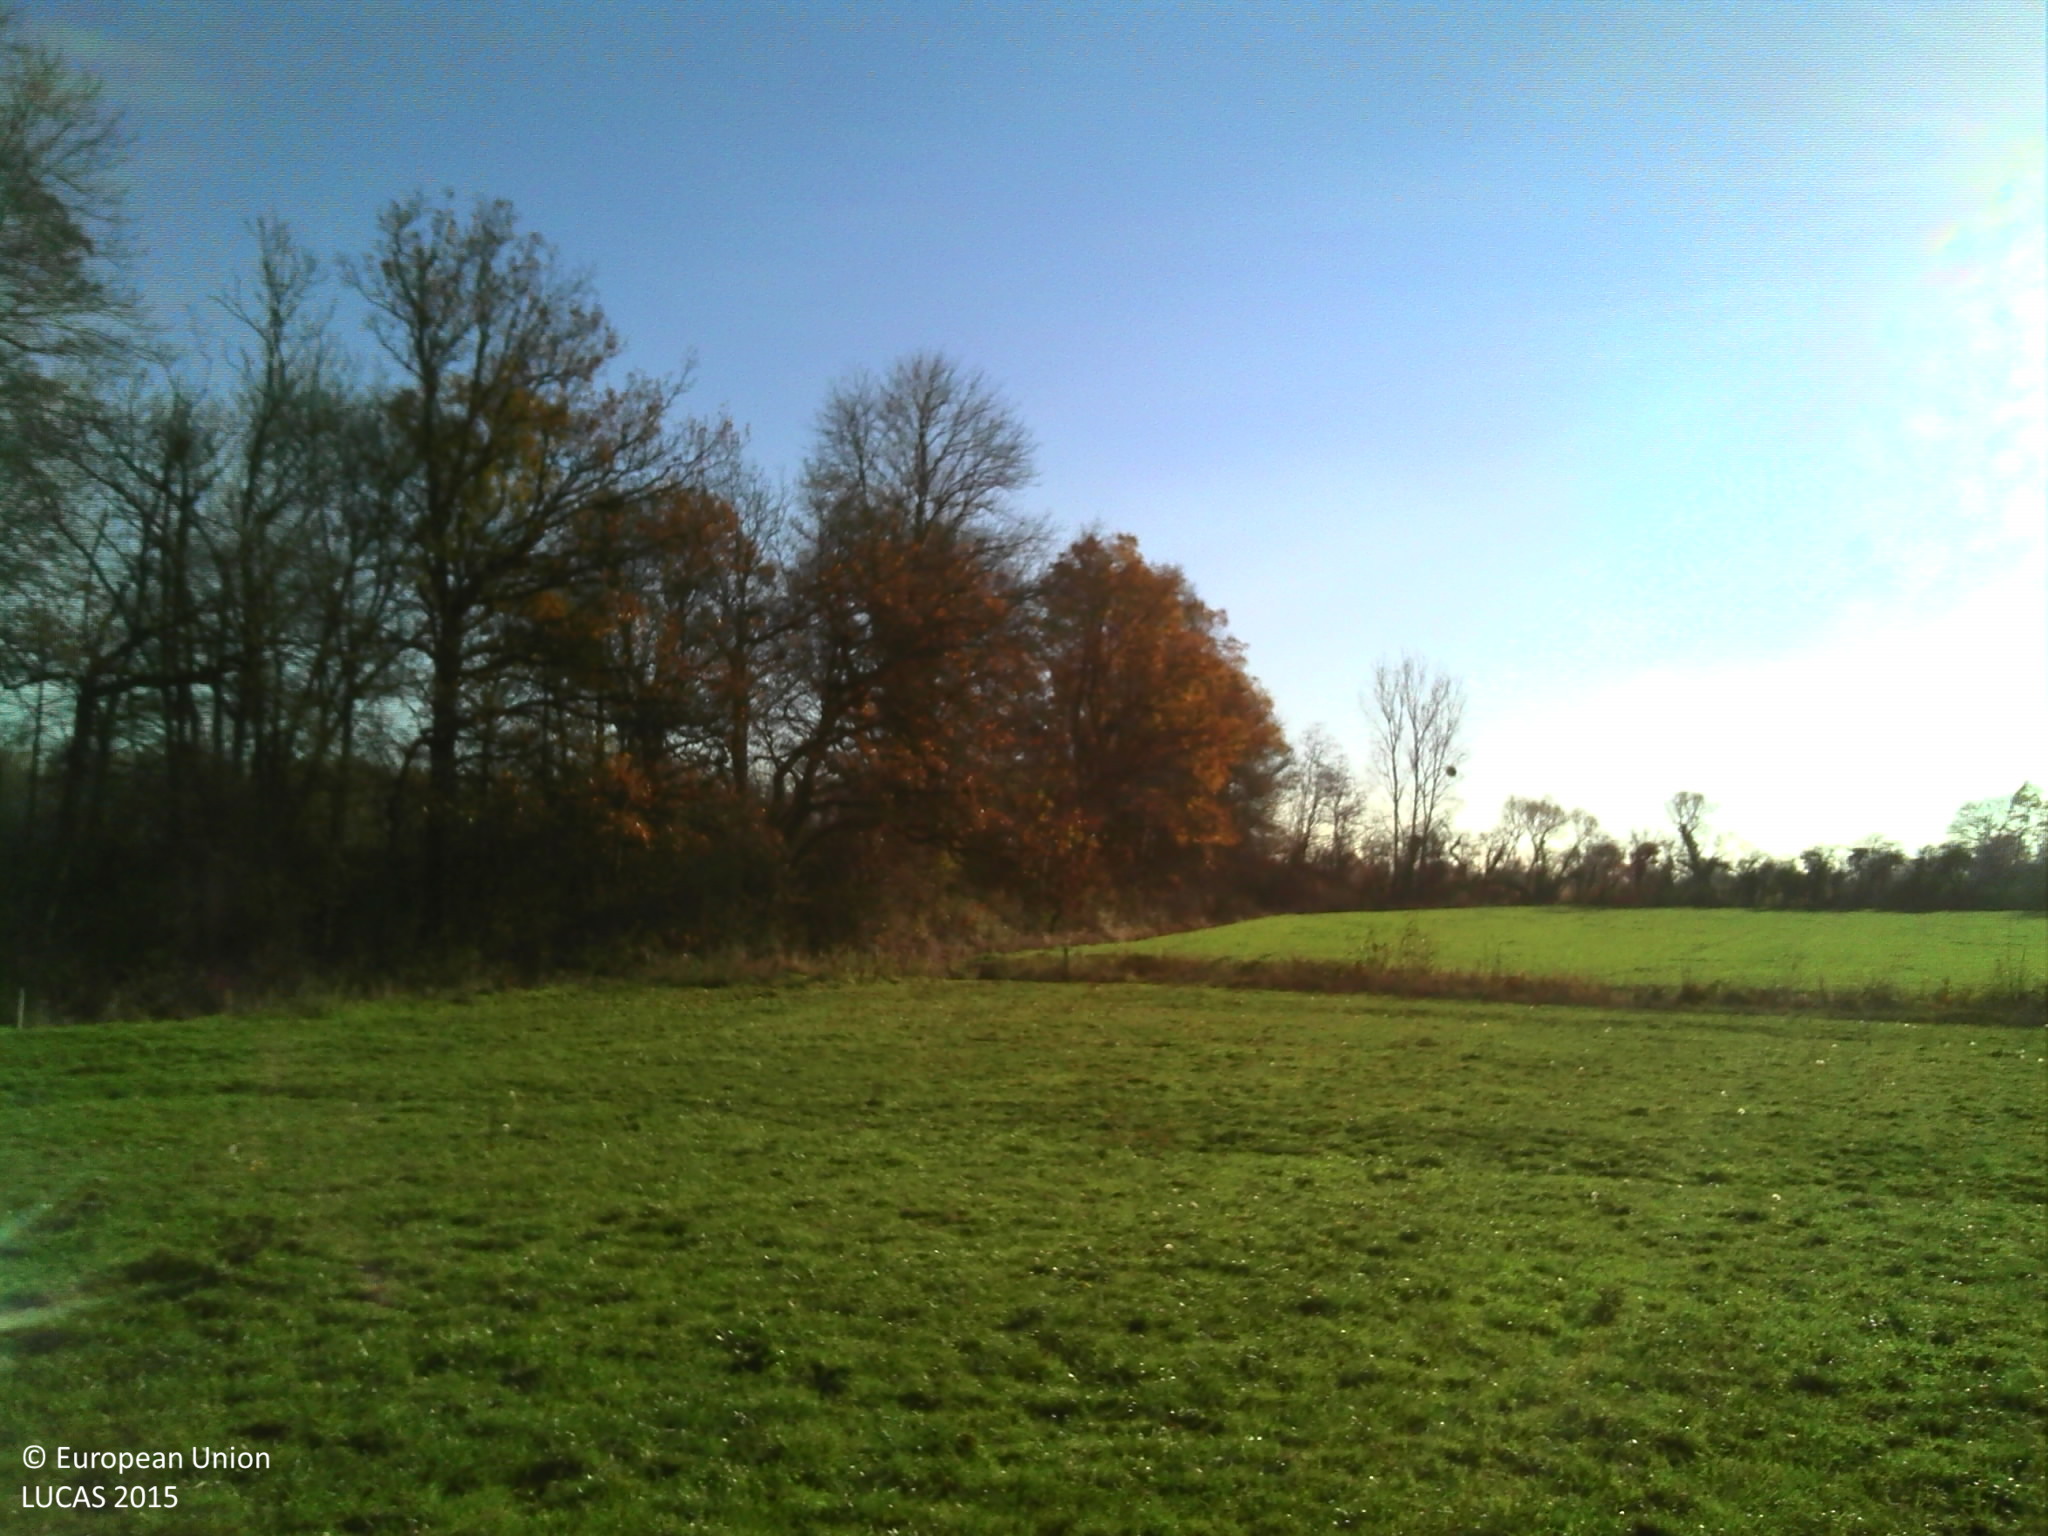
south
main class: Grassland
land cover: Grassland without tree/shrub cover
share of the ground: > 75 %
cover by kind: herbaceous plants 100 %
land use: Agriculture (excluding fallow land and kitchen gardens)
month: December
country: FR
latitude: 46.0323
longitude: 4.9255
